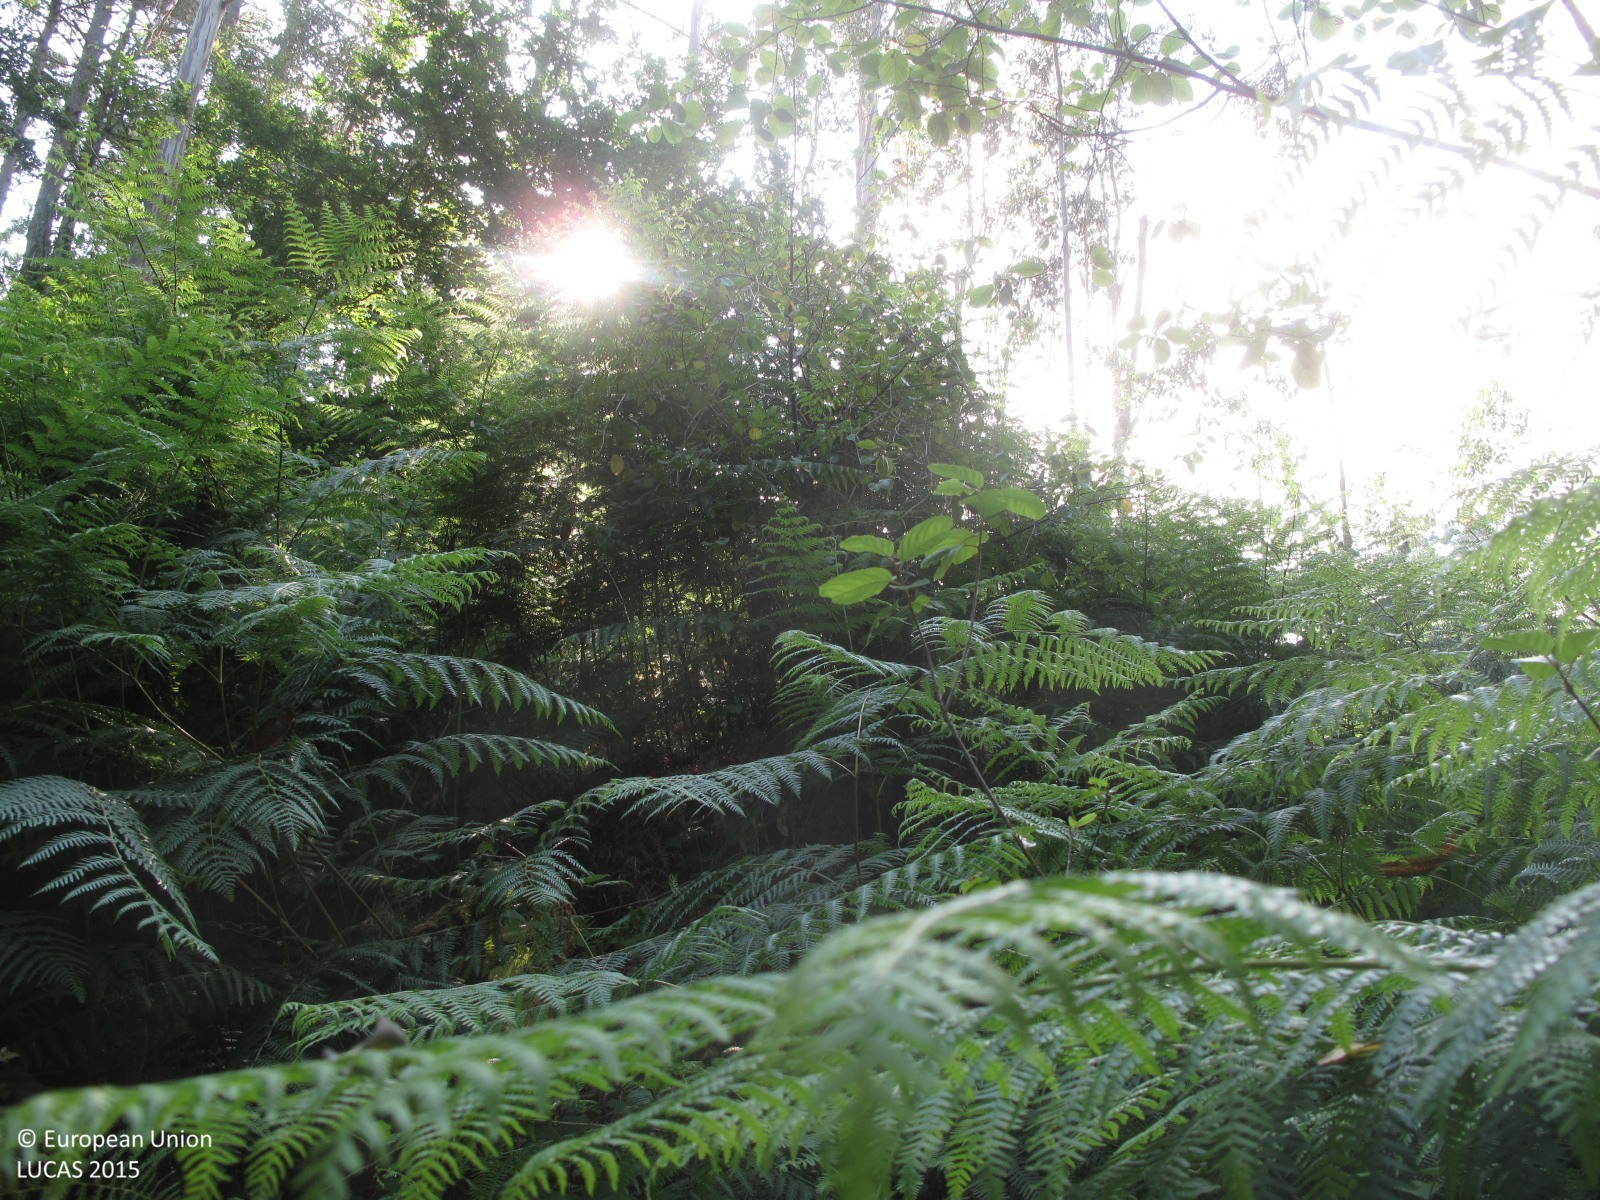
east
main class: Woodland
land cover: Broadleaved woodland
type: exotic forest
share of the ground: 50 - 75 %
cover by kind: broadleaved forest trees 60 %, shrubs 20 %, herbaceous plants 20 %
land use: Forestry
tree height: > 5 m
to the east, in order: Broadleaved woodland; Paved roads, cycling and walking lanes; Broadleaved woodland; Pine dominated coniferous woodland; Broadleaved woodland; Rivers and streams; Broadleaved woodland
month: July
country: ES
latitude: 43.2864
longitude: -8.1529
